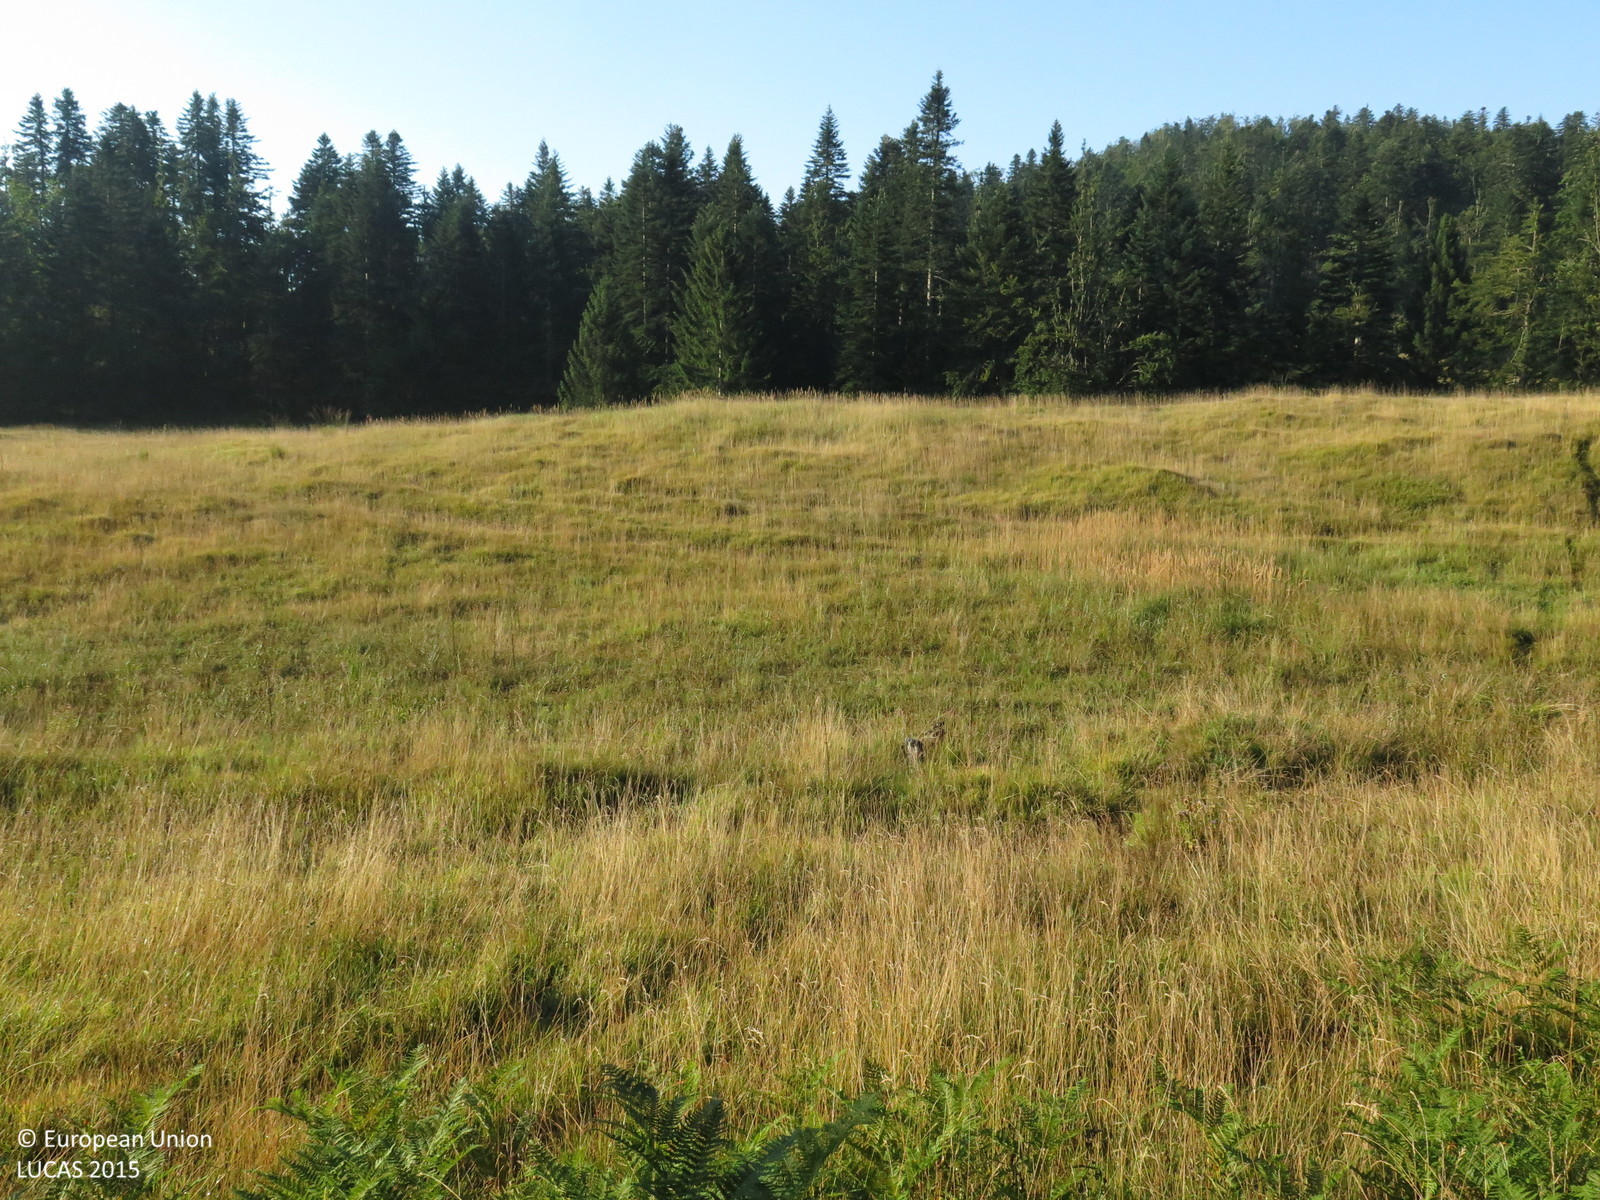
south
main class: Woodland
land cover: Other mixed woodland
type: mountainous beech forest
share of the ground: > 75 %
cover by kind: coniferous forest trees 75 %, broadleaved forest trees 25 %
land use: Forestry
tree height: > 5 m
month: September
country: HR
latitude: 45.5118
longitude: 14.6163
